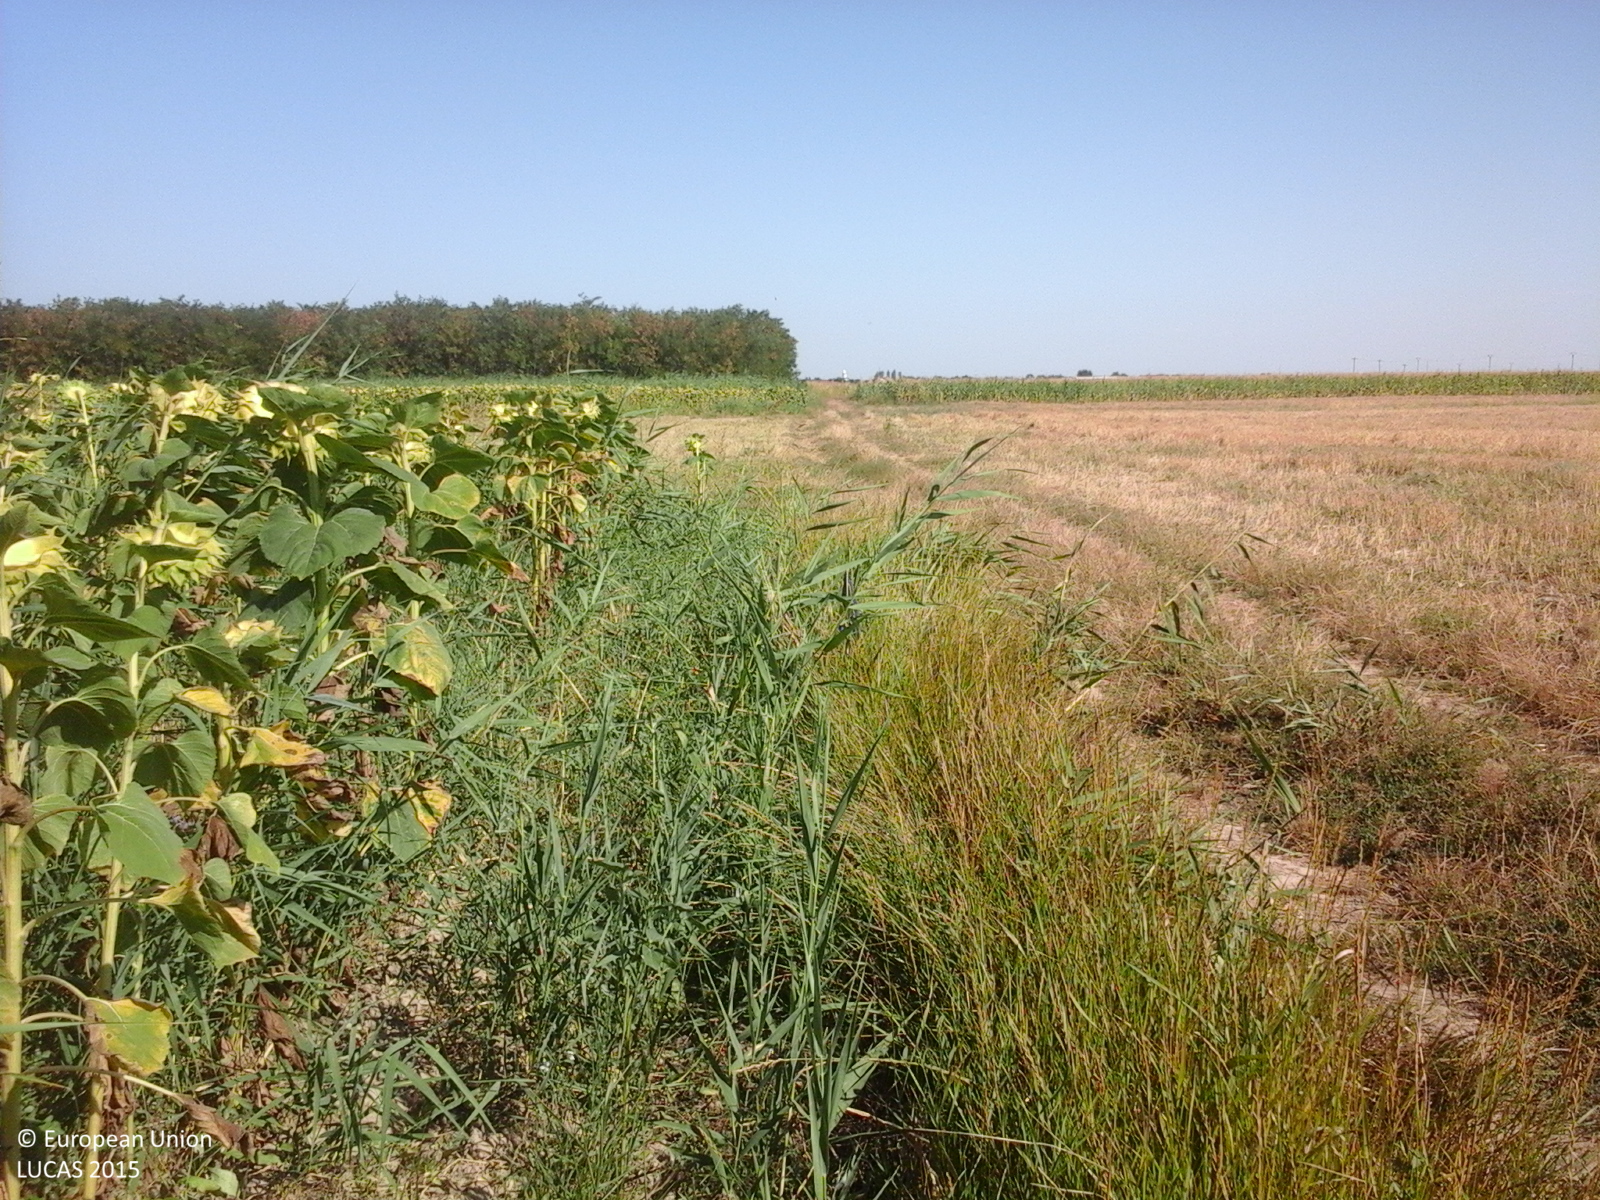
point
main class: Cropland
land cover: Sunflower
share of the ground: > 75 %
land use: Agriculture (excluding fallow land and kitchen gardens)
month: August
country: RO
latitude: 45.5981
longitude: 27.4734
